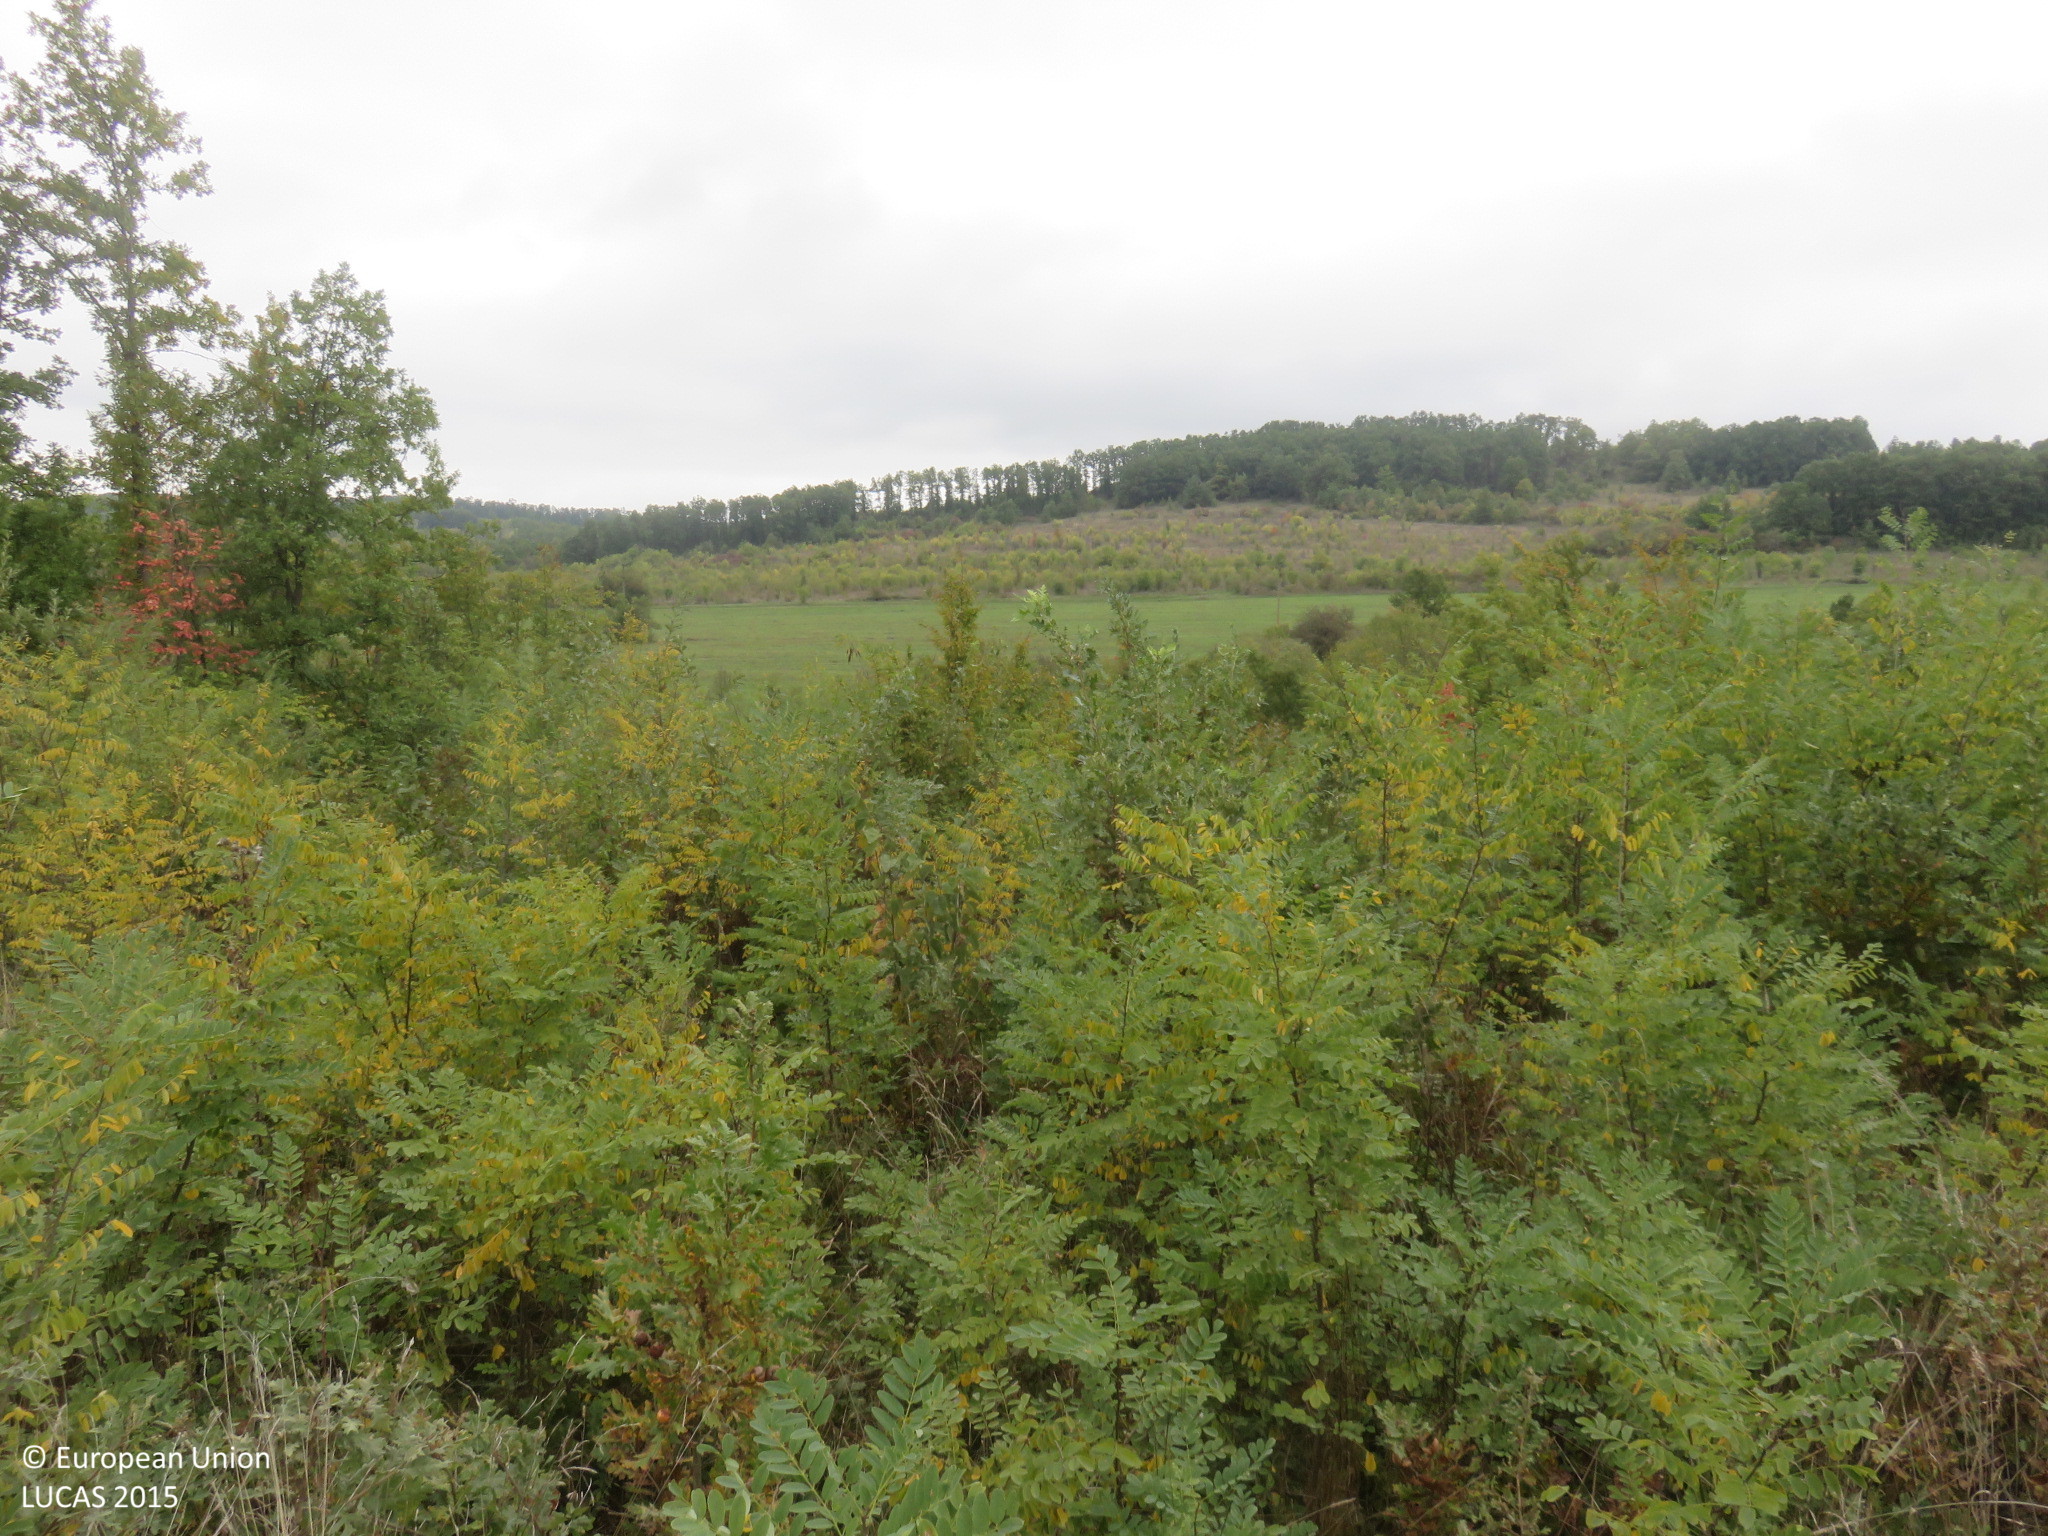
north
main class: Woodland
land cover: Broadleaved woodland
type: mesophytic deciduous forest
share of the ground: > 75 %
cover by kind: shrubs 75 %, broadleaved forest trees 25 %
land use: Forestry
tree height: < 5 m
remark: Clear cut
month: October
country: BG
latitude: 43.0037
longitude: 25.1956
